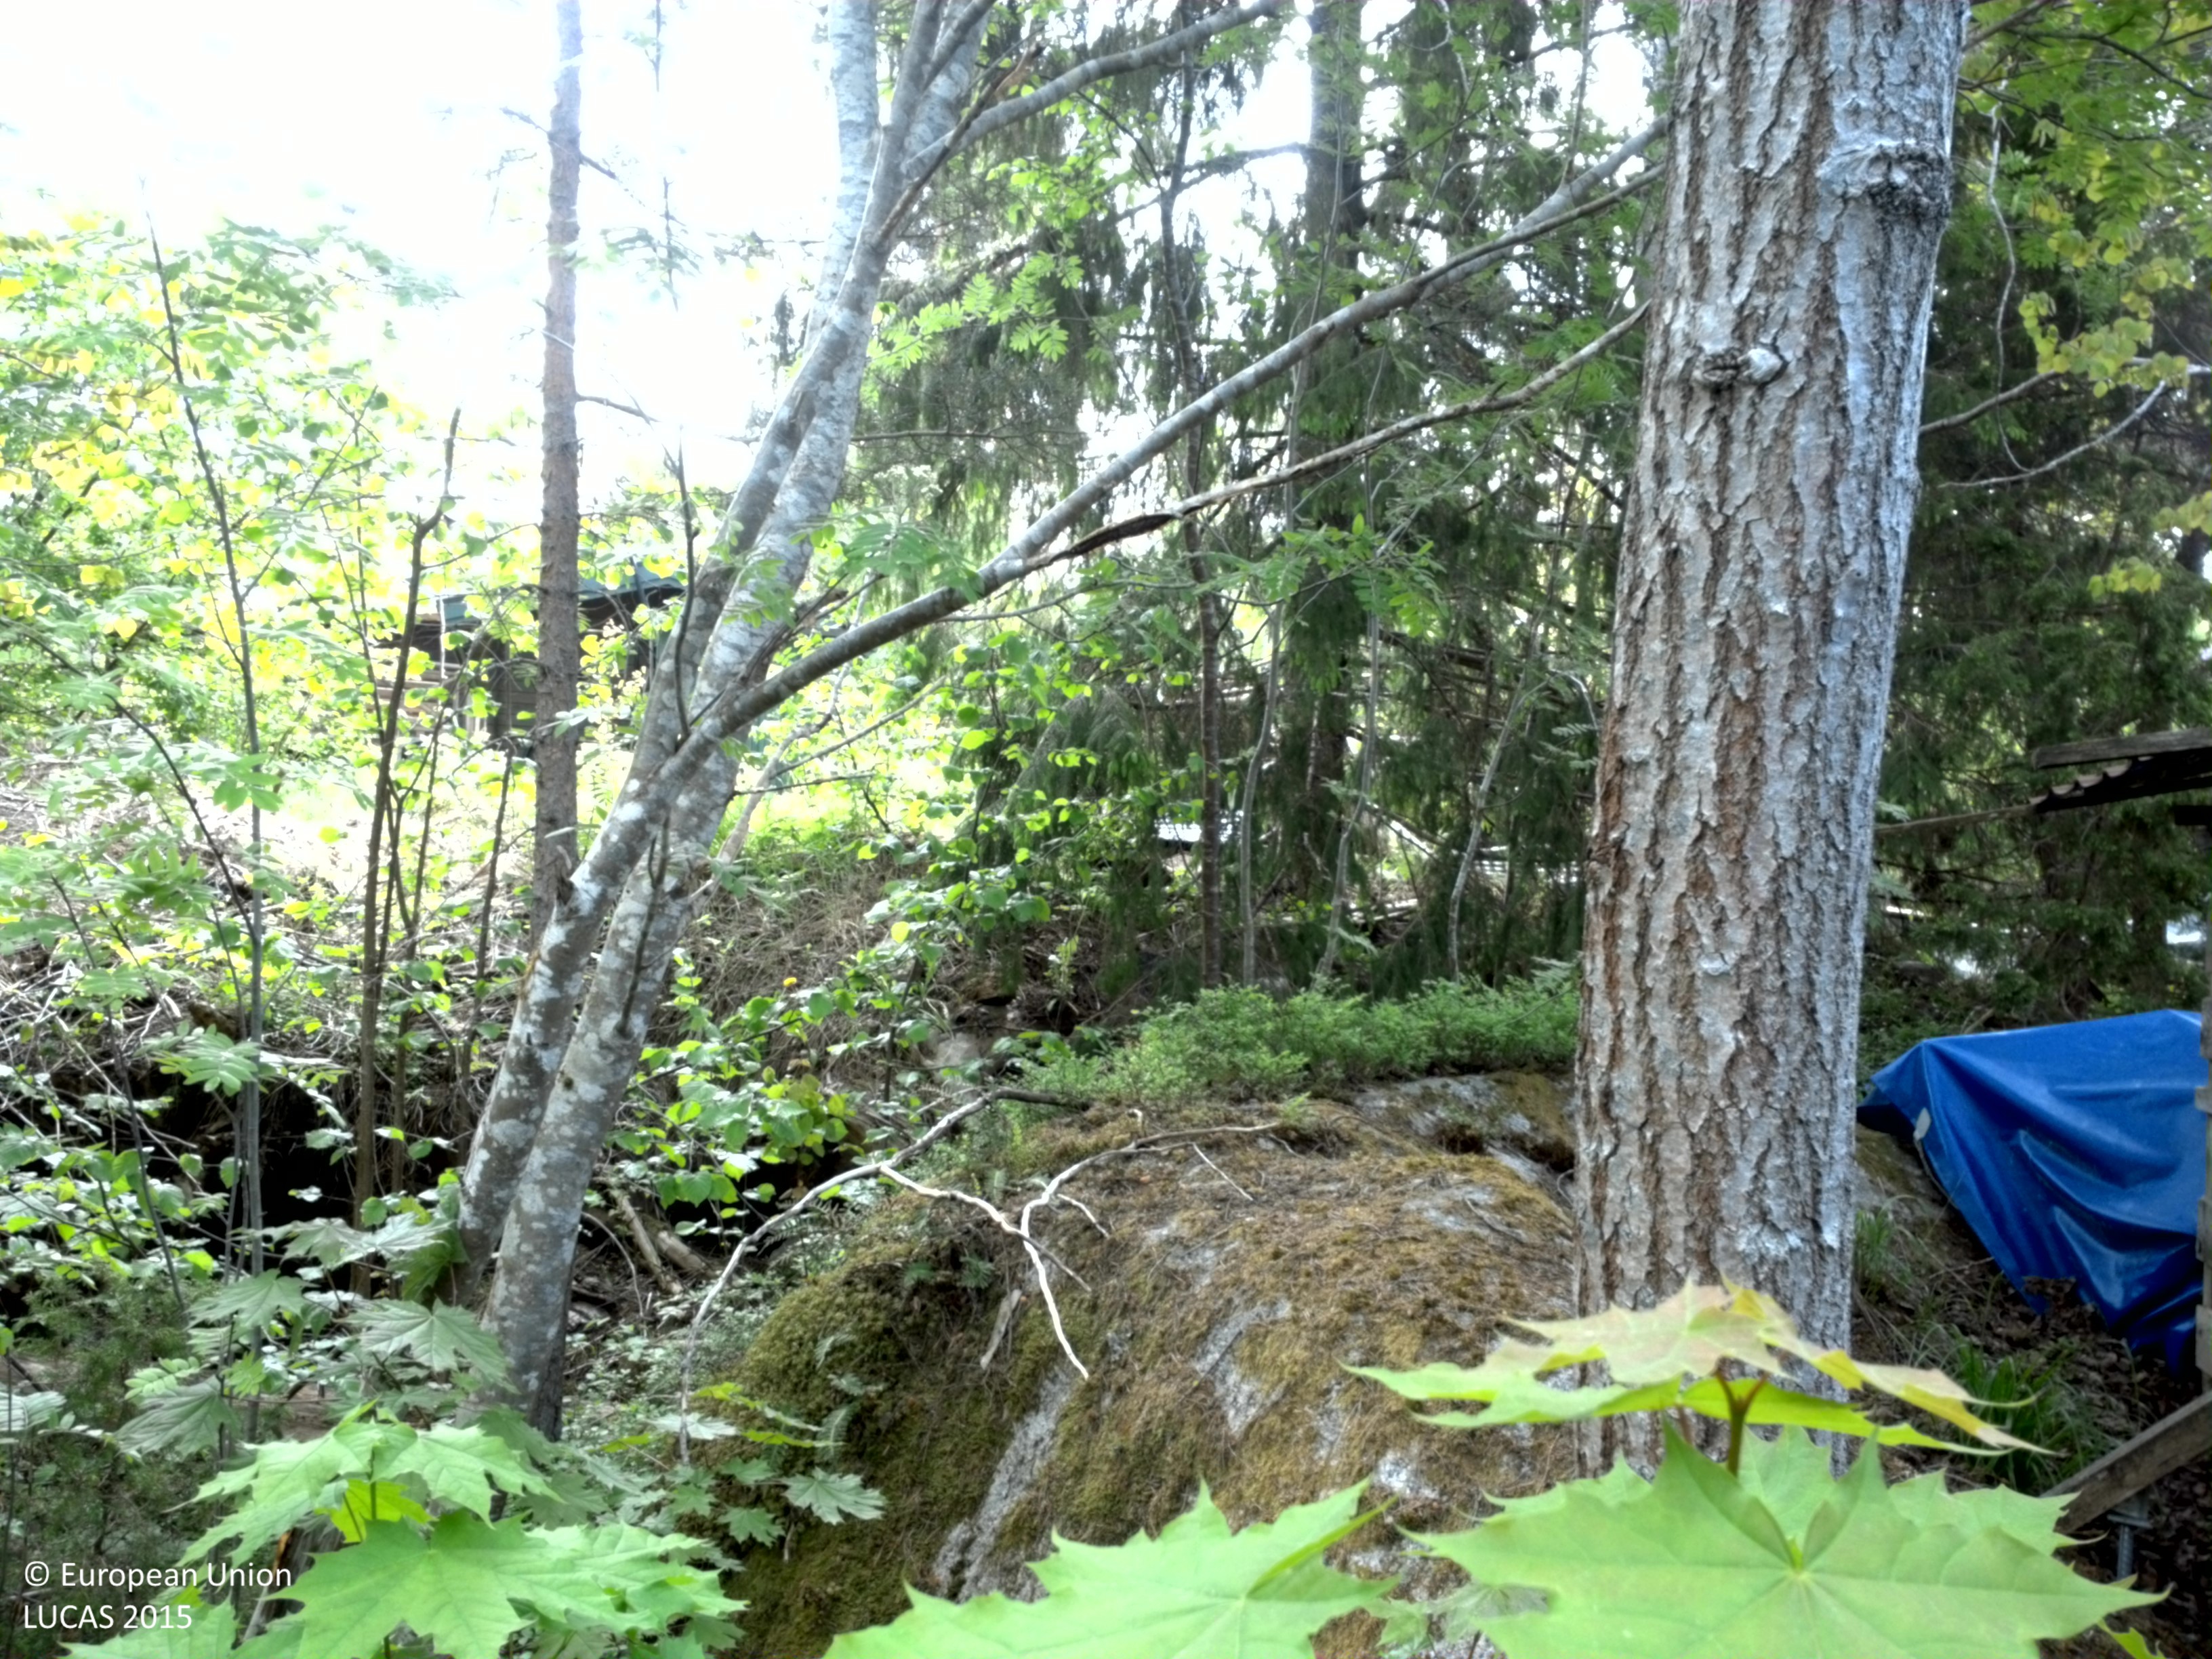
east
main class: Woodland
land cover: Spruce dominated mixed woodland
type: hemiboreal forest and nemoral coniferous forest and mixed broadleaved-coniferous forest
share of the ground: > 75 %
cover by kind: coniferous forest trees 50 %, broadleaved forest trees 30 %, shrubs 10 %, herbaceous plants 5 %, lichens and mosses 5 %
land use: Forestry
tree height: > 5 m
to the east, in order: Spruce dominated mixed woodland; Artificial constructions in urban areas; Spruce dominated mixed woodland; Fences; Rocks and stones; Ditches and canals; Paved roads, cycling and walking lanes; Ditches and canals; Spruce dominated mixed woodland; Artificial constructions in urban areas; Pine dominated coniferous woodland; Artificial constructions in urban areas; Other bare soil; Spruce dominated coniferous woodland
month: June
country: SE
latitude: 59.7574
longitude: 18.8475
